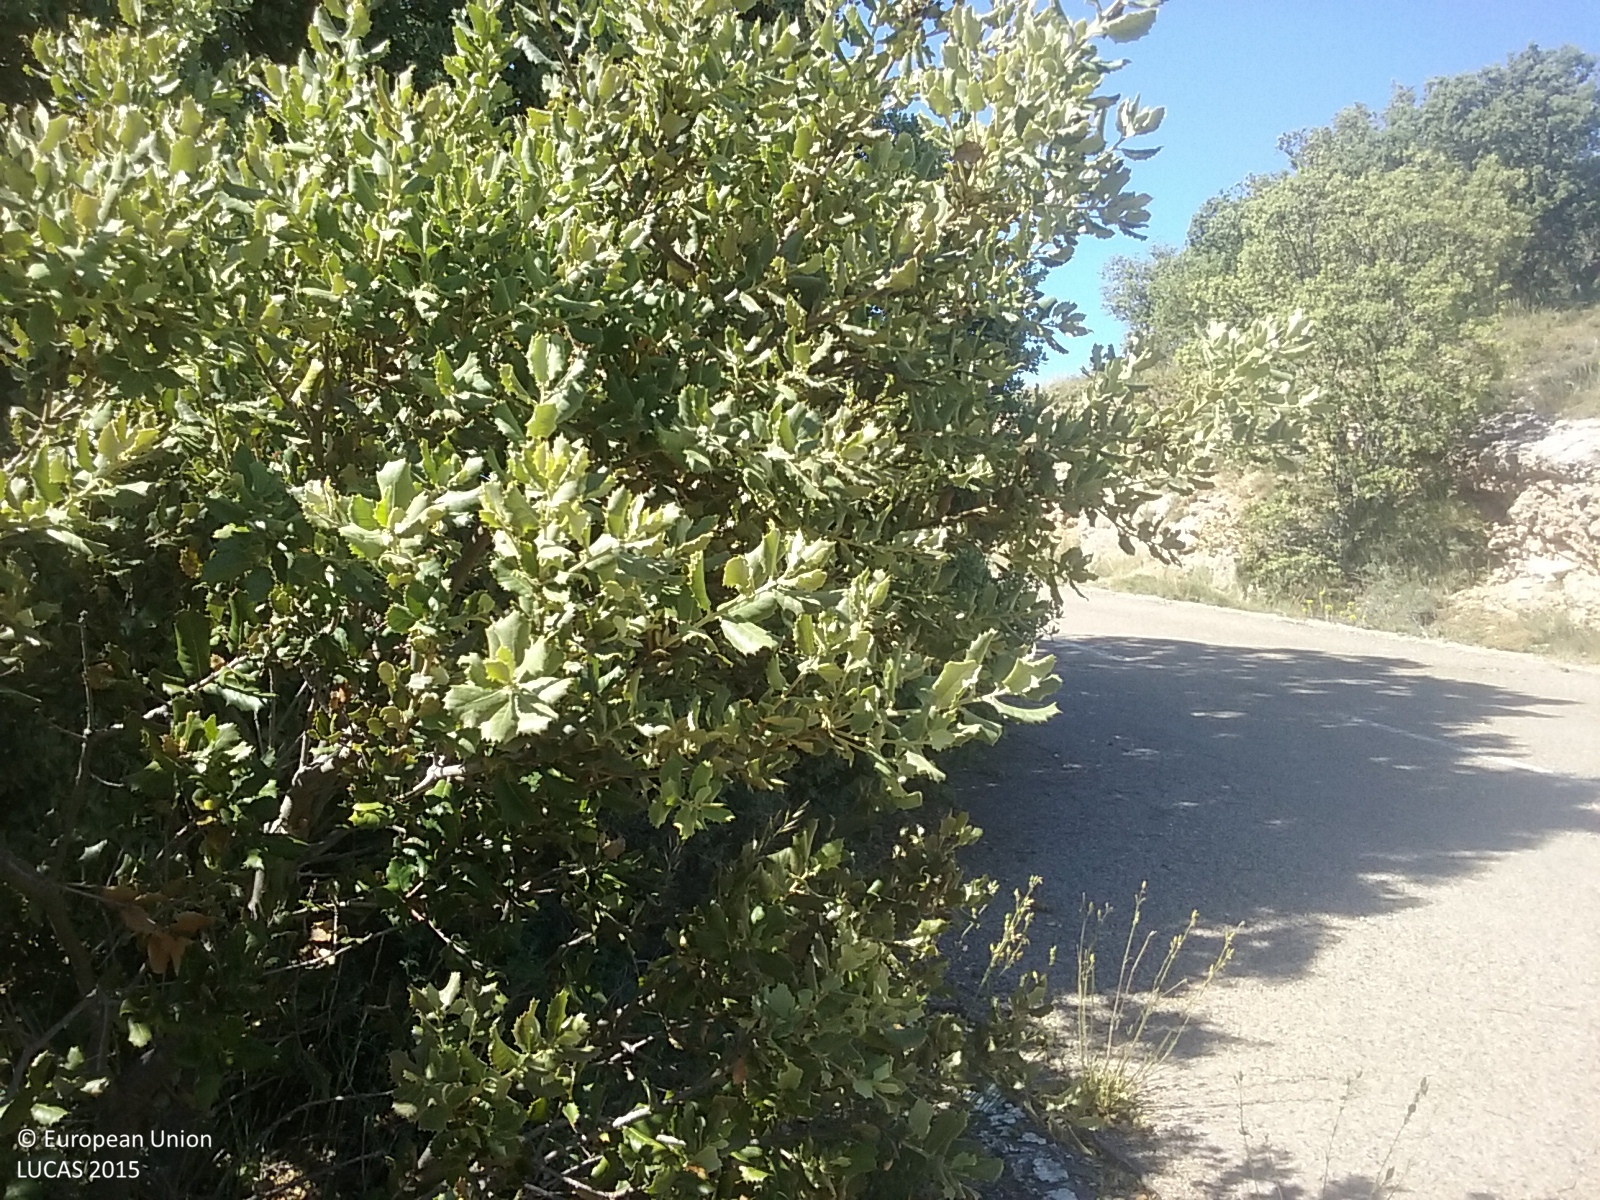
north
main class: Woodland
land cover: Broadleaved woodland
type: broadleaved evergreen forest
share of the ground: 50 - 75 %
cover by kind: broadleaved forest trees 60 %, shrubs 20 %, herbaceous plants 10 %, unconsolidated bare surface 10 %
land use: Forestry
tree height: < 5 m
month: June
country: ES
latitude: 40.6584
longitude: -0.0728
